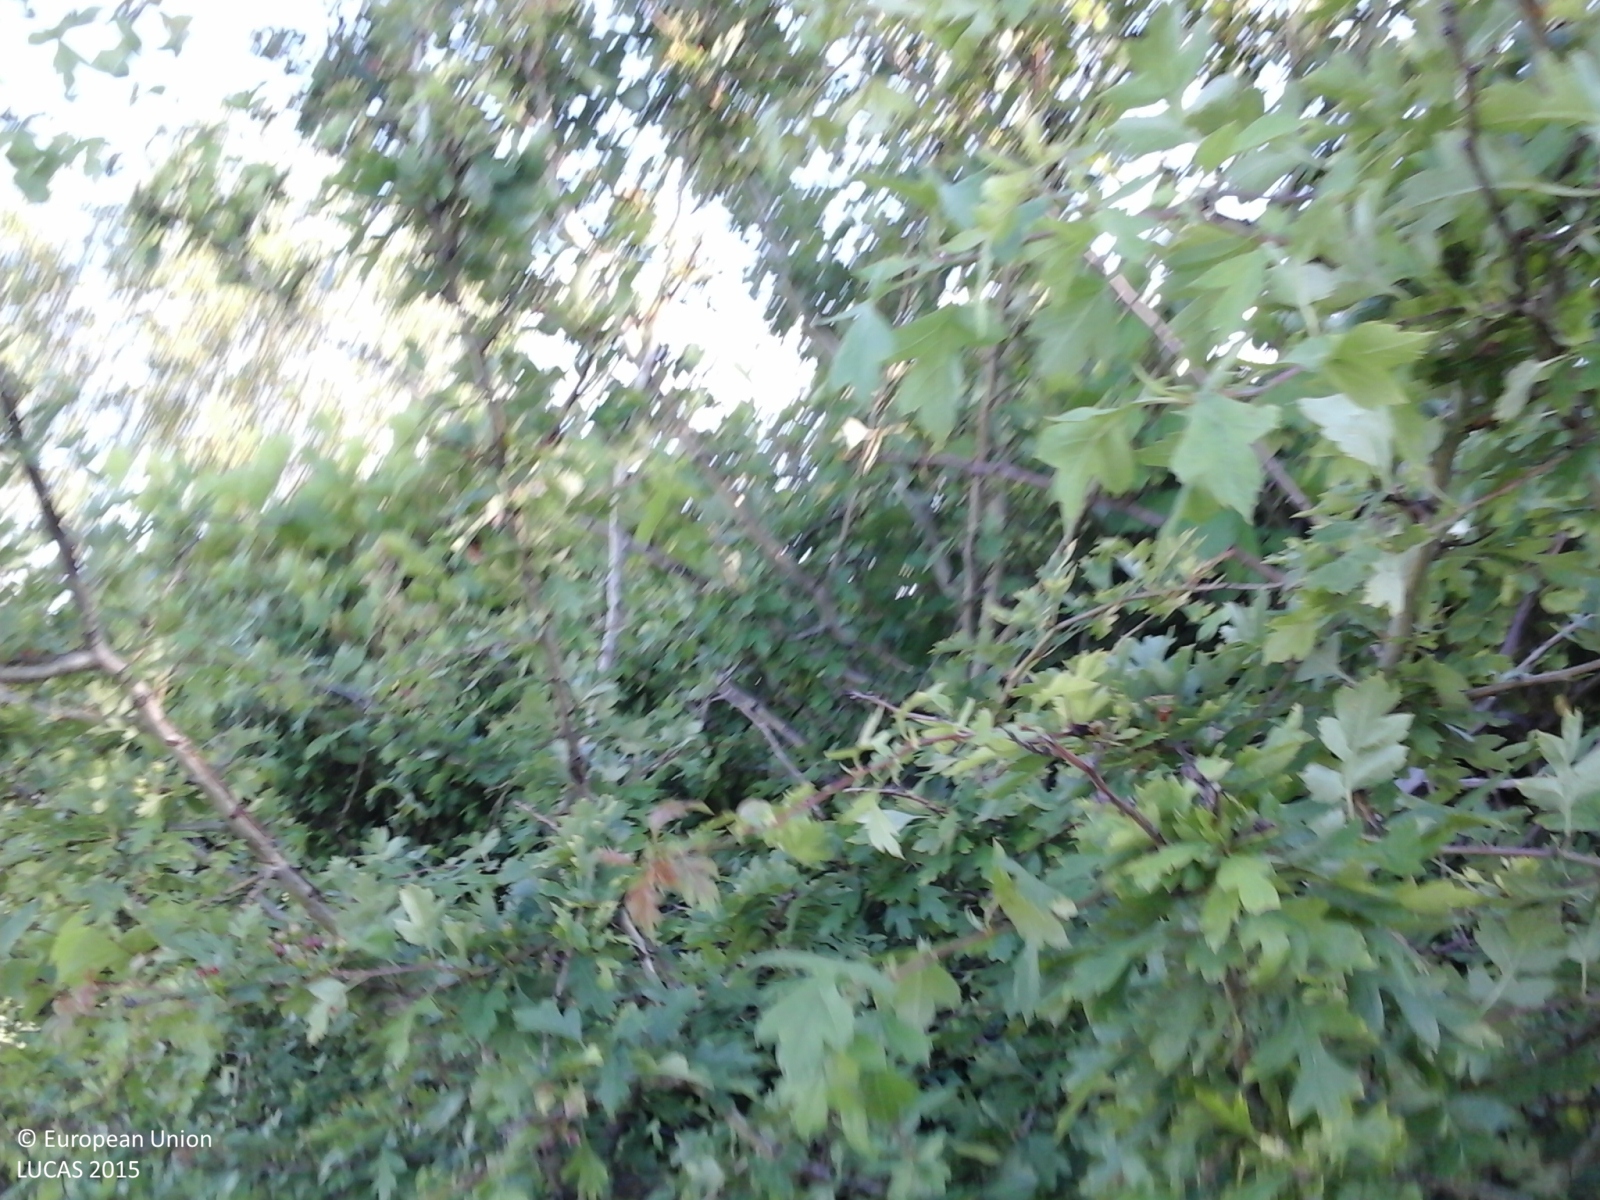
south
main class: Shrubland
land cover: Shrubland with sparse tree cover
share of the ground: > 75 %
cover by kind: shrubs 90 %, broadleaved forest trees 5 %, herbaceous plants 5 %
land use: Semi-natural and natural areas not in use
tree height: > 5 m
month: May
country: IT
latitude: 44.1038
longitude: 12.5054
